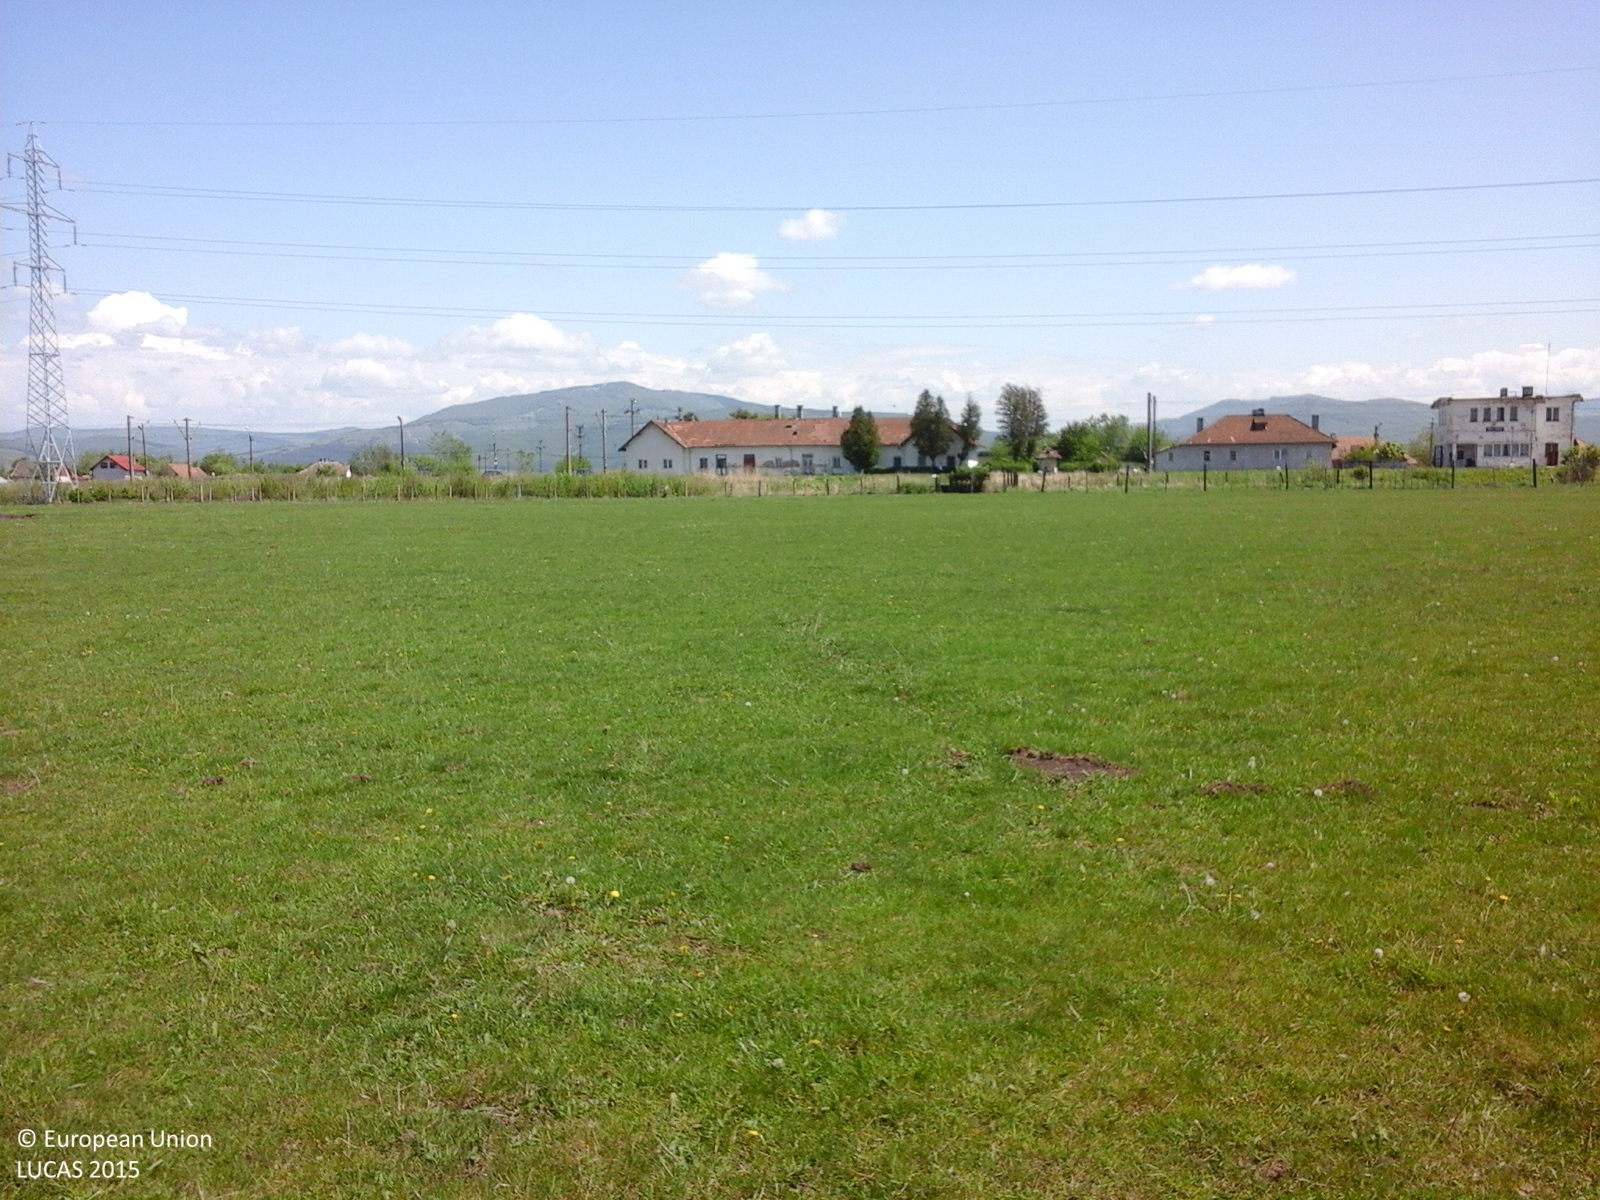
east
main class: Grassland
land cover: Grassland without tree/shrub cover
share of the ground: > 75 %
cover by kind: herbaceous plants 100 %
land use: Agriculture (excluding fallow land and kitchen gardens)
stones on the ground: < 10 %
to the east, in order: Grassland without tree/shrub cover; Tracks; Grassland without tree/shrub cover; Electric lines; Grassland without tree/shrub cover; Fences; Potatoes; Fences; Inland marshes; Spontaneously vegetated surfaces; Railways; Grass margins; Tracks; Electric lines; Grassland without tree/shrub cover
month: May
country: RO
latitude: 45.7396
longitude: 25.7763
